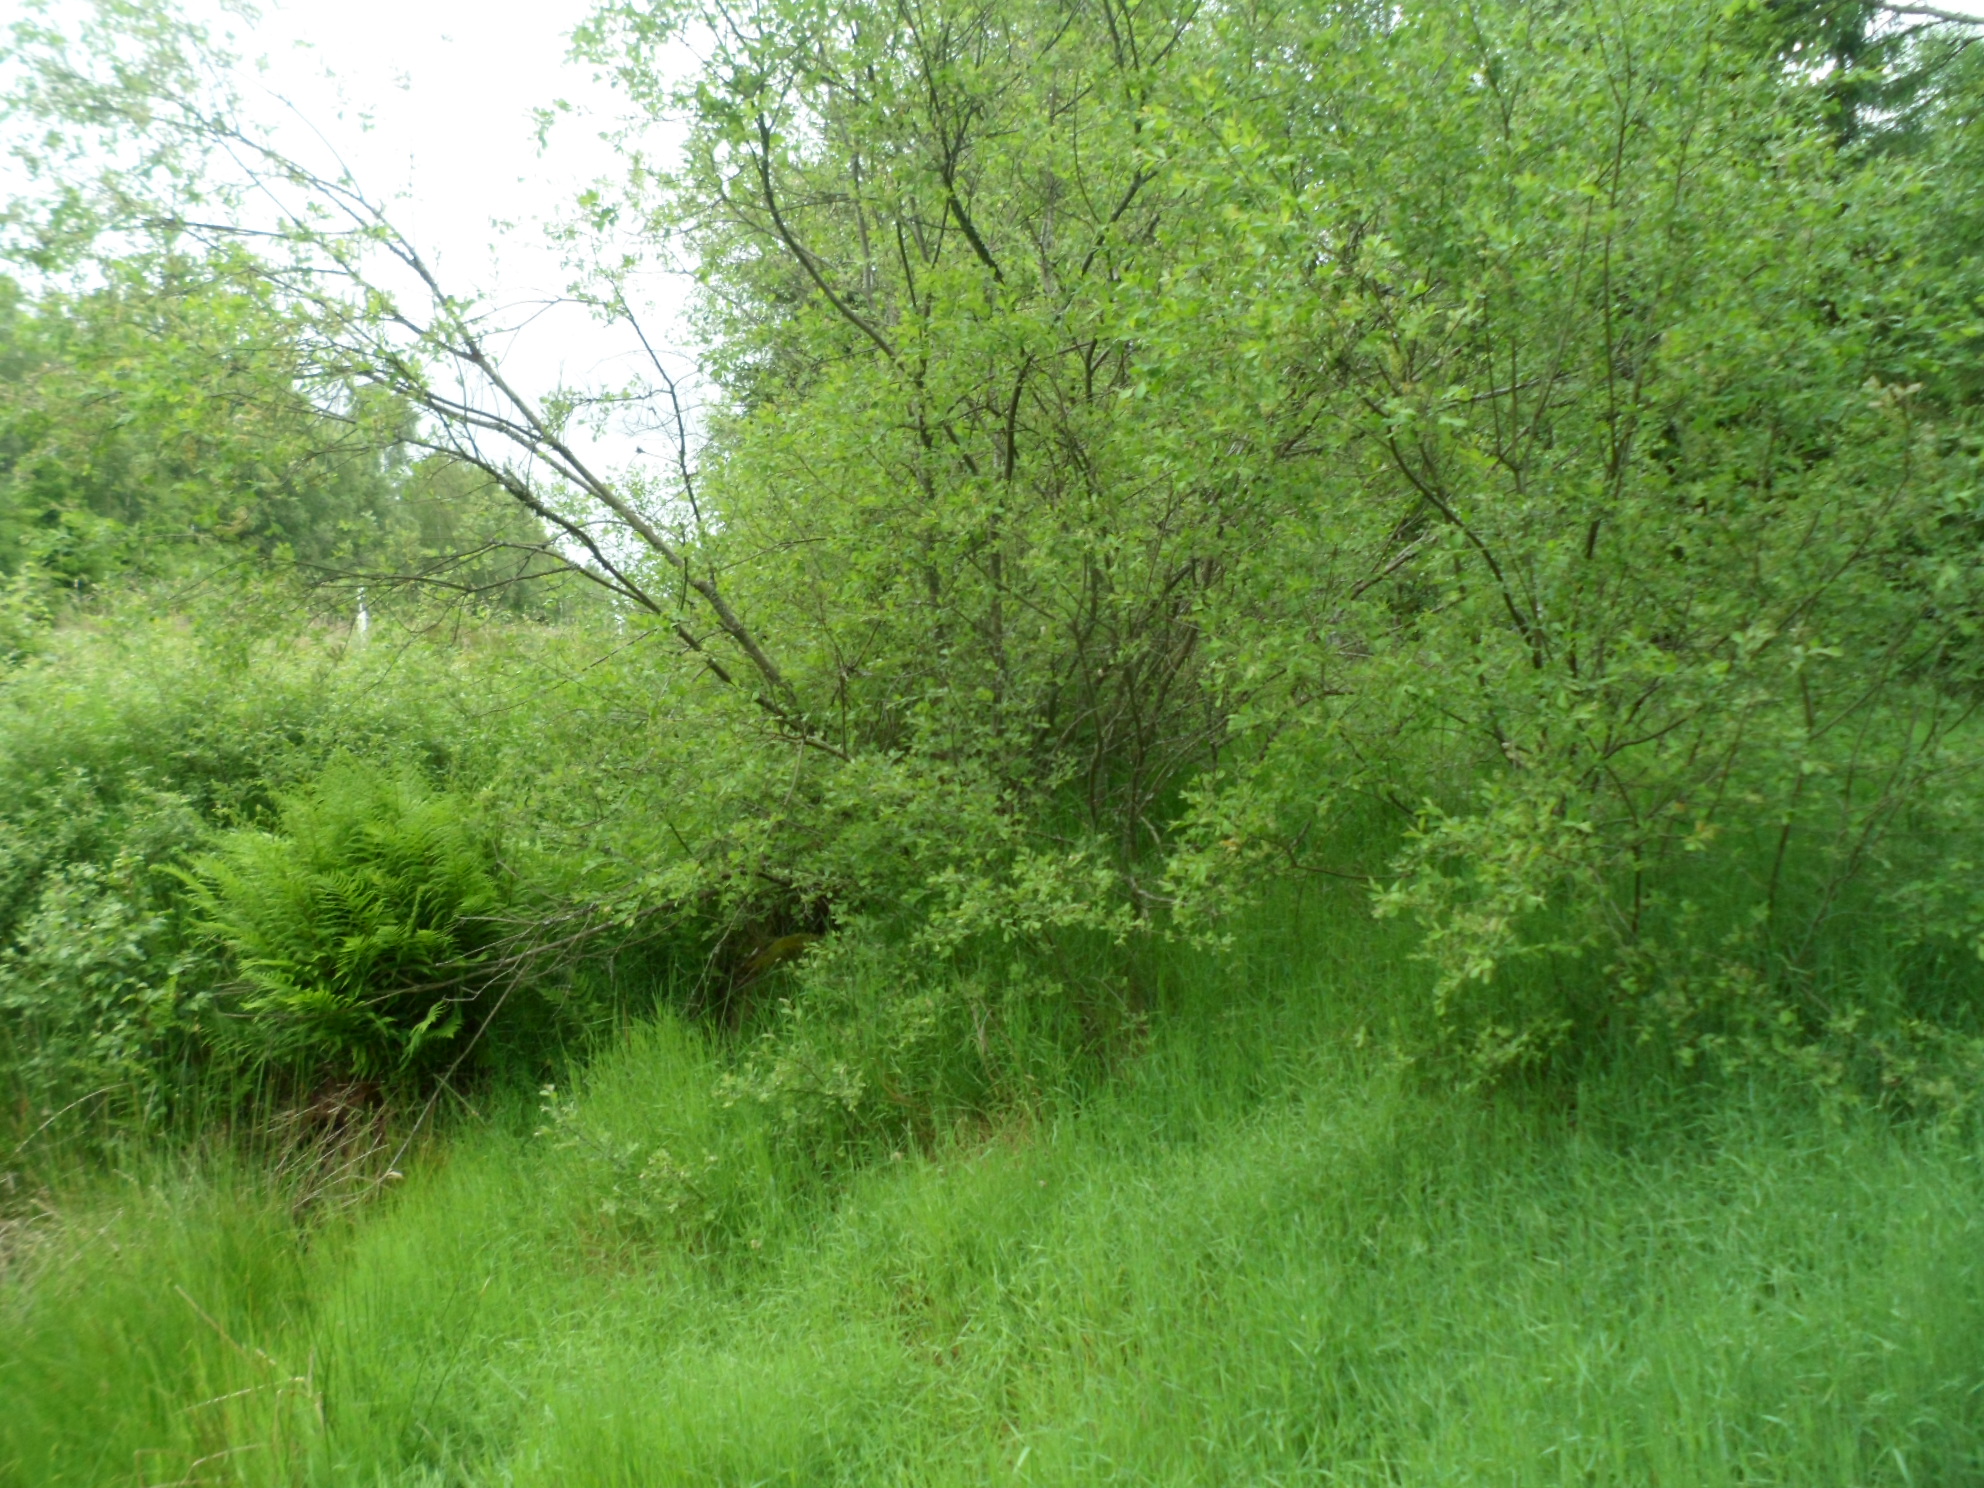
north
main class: Woodland
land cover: Broadleaved woodland
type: boreal forest
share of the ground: 50 - 75 %
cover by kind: broadleaved forest trees 55 %, herbaceous plants 20 %, shrubs 10 %, lichens and mosses 10 %, coniferous forest trees 5 %
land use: Forestry
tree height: > 5 m
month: June
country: SE
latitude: 57.0738
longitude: 15.1933
